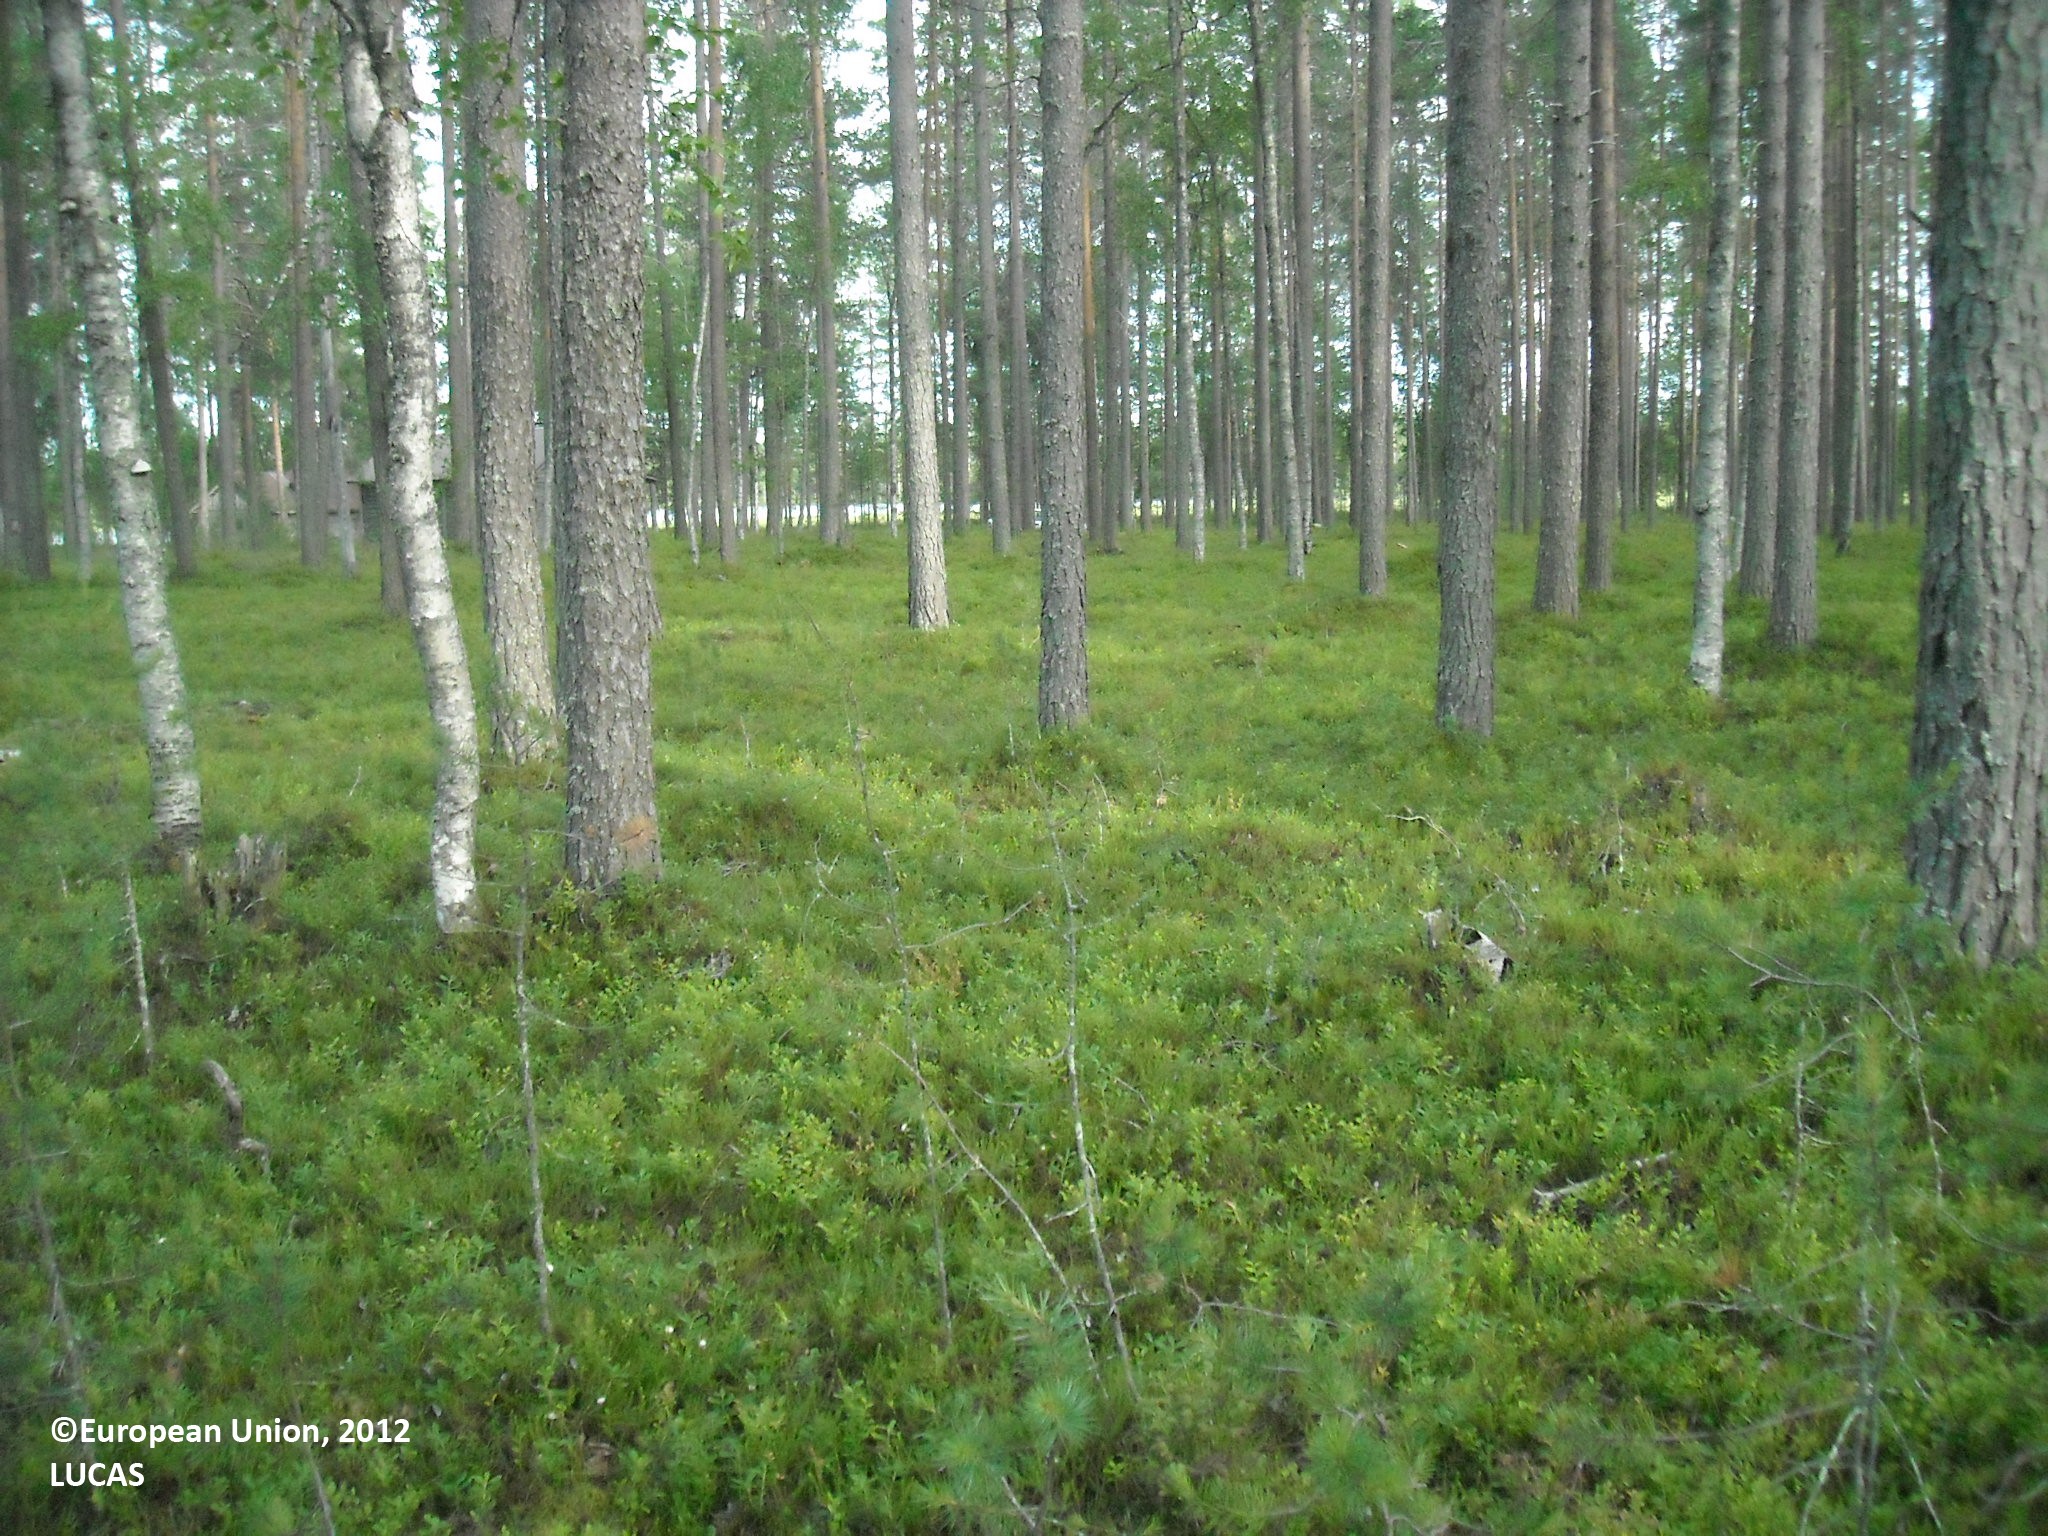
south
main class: Woodland
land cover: Pine dominated mixed woodland
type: boreal forest
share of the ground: 50 - 75 %
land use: Forestry
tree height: > 5 m
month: July
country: FI
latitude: 65.0834
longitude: 26.8585
